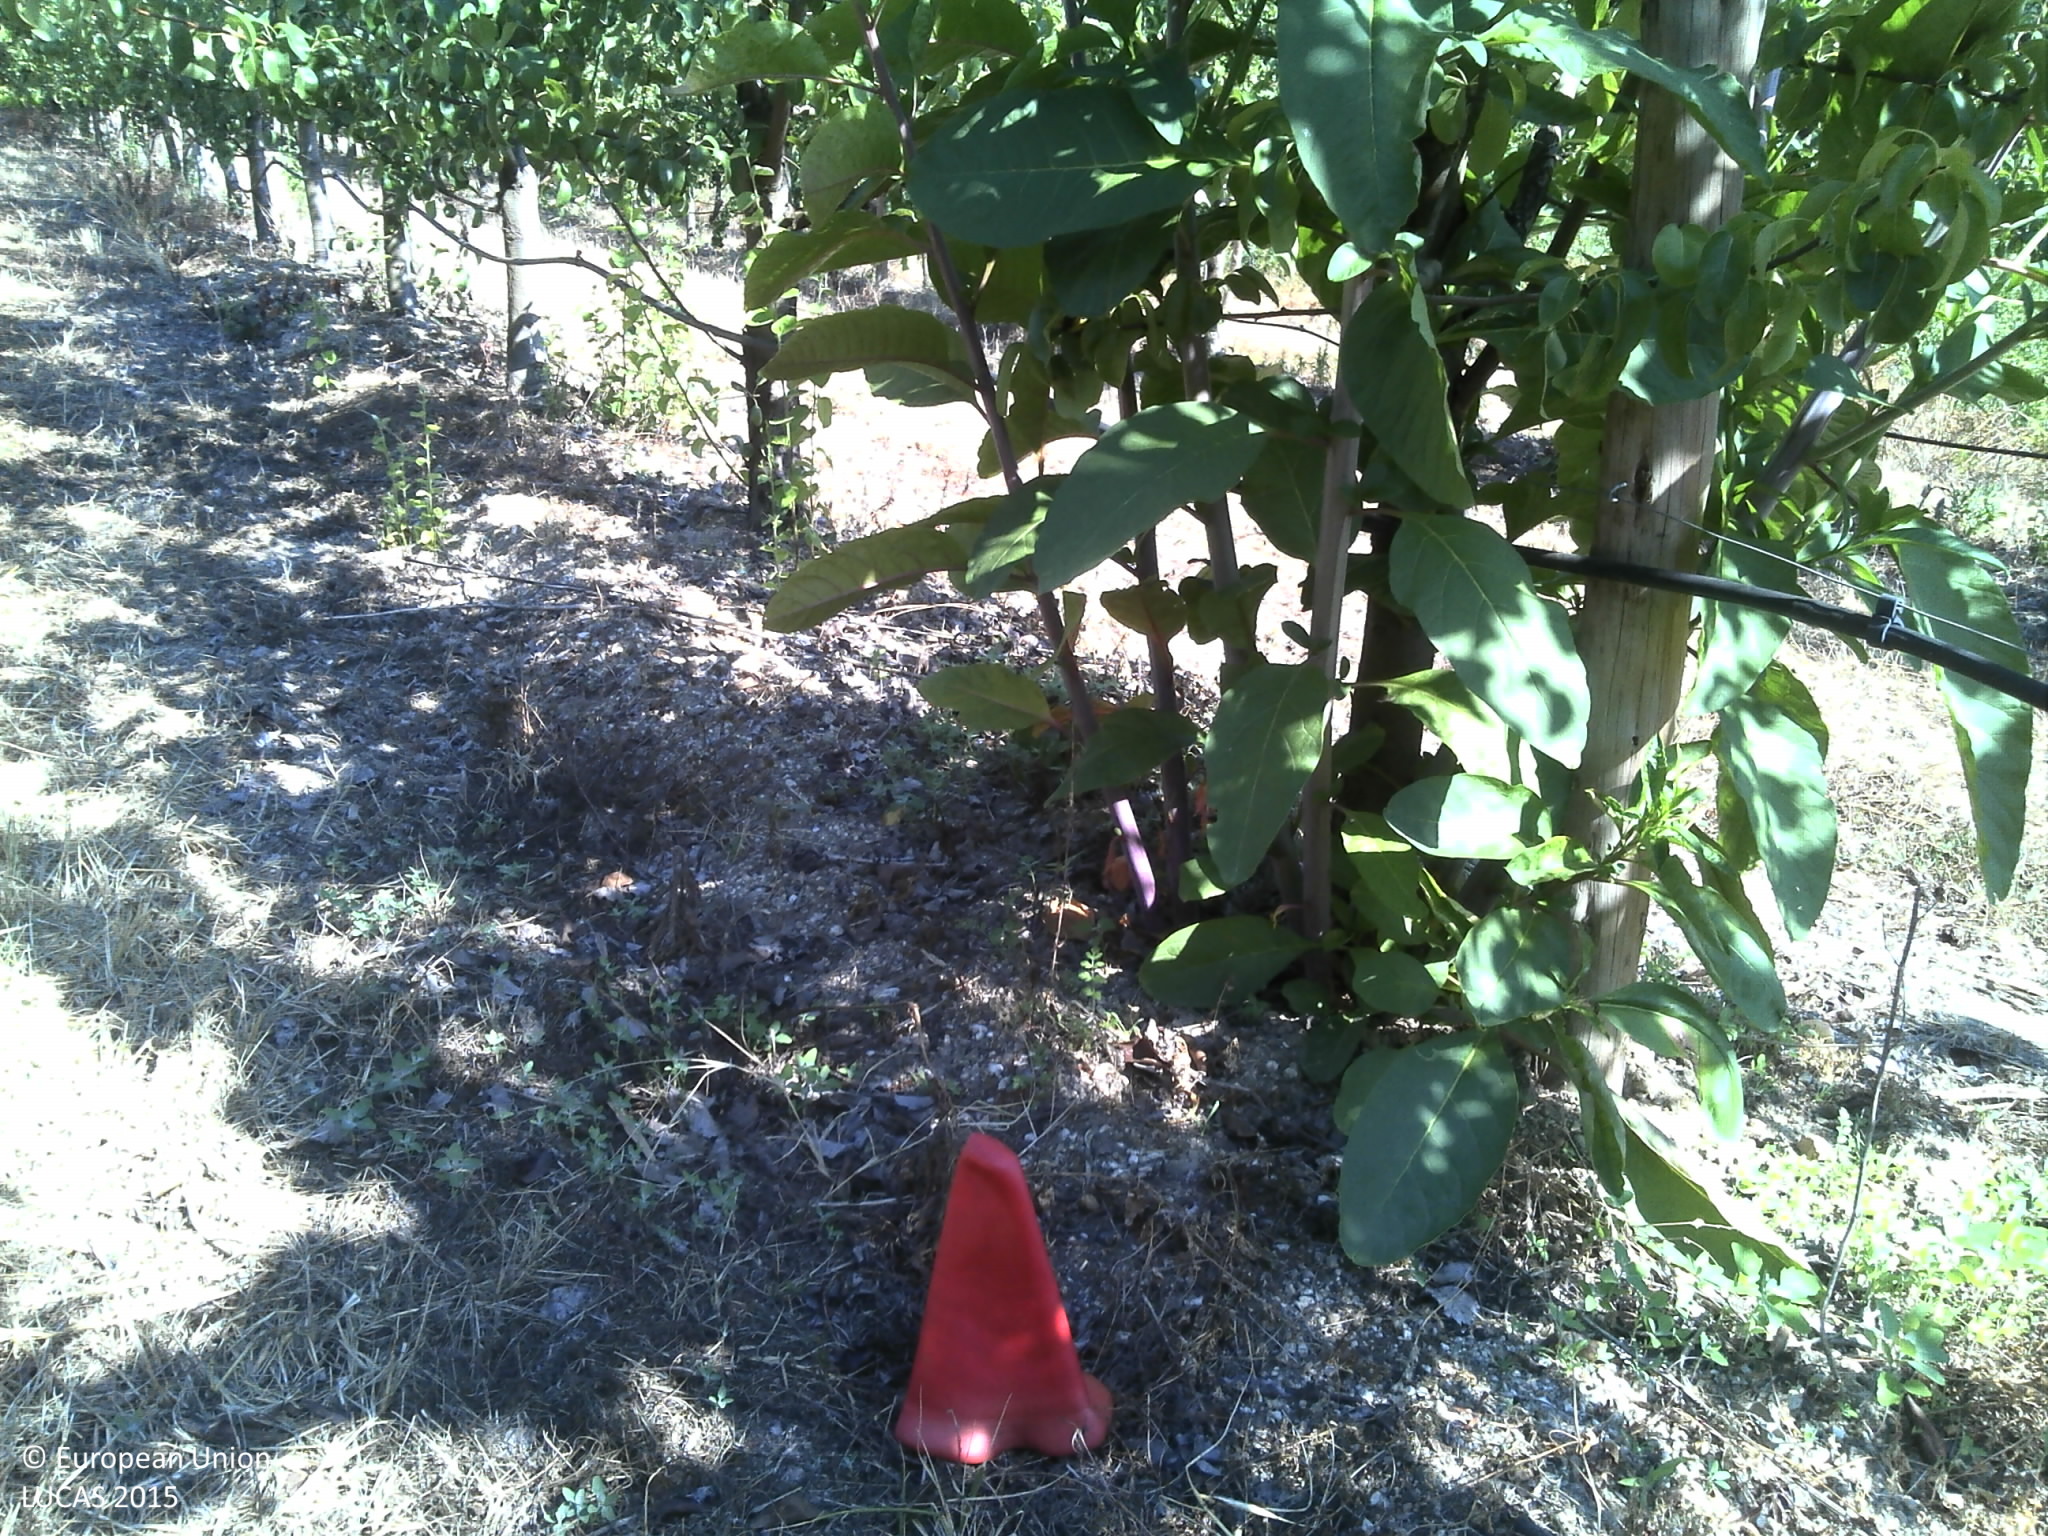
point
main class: Cropland
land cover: Pear fruit
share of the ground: 25 - 50 %
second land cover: Grassland without tree/shrub cover
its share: 25 - 50 %
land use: Agriculture (excluding fallow land and kitchen gardens)
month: July
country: PT
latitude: 40.3721
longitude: -7.9394
